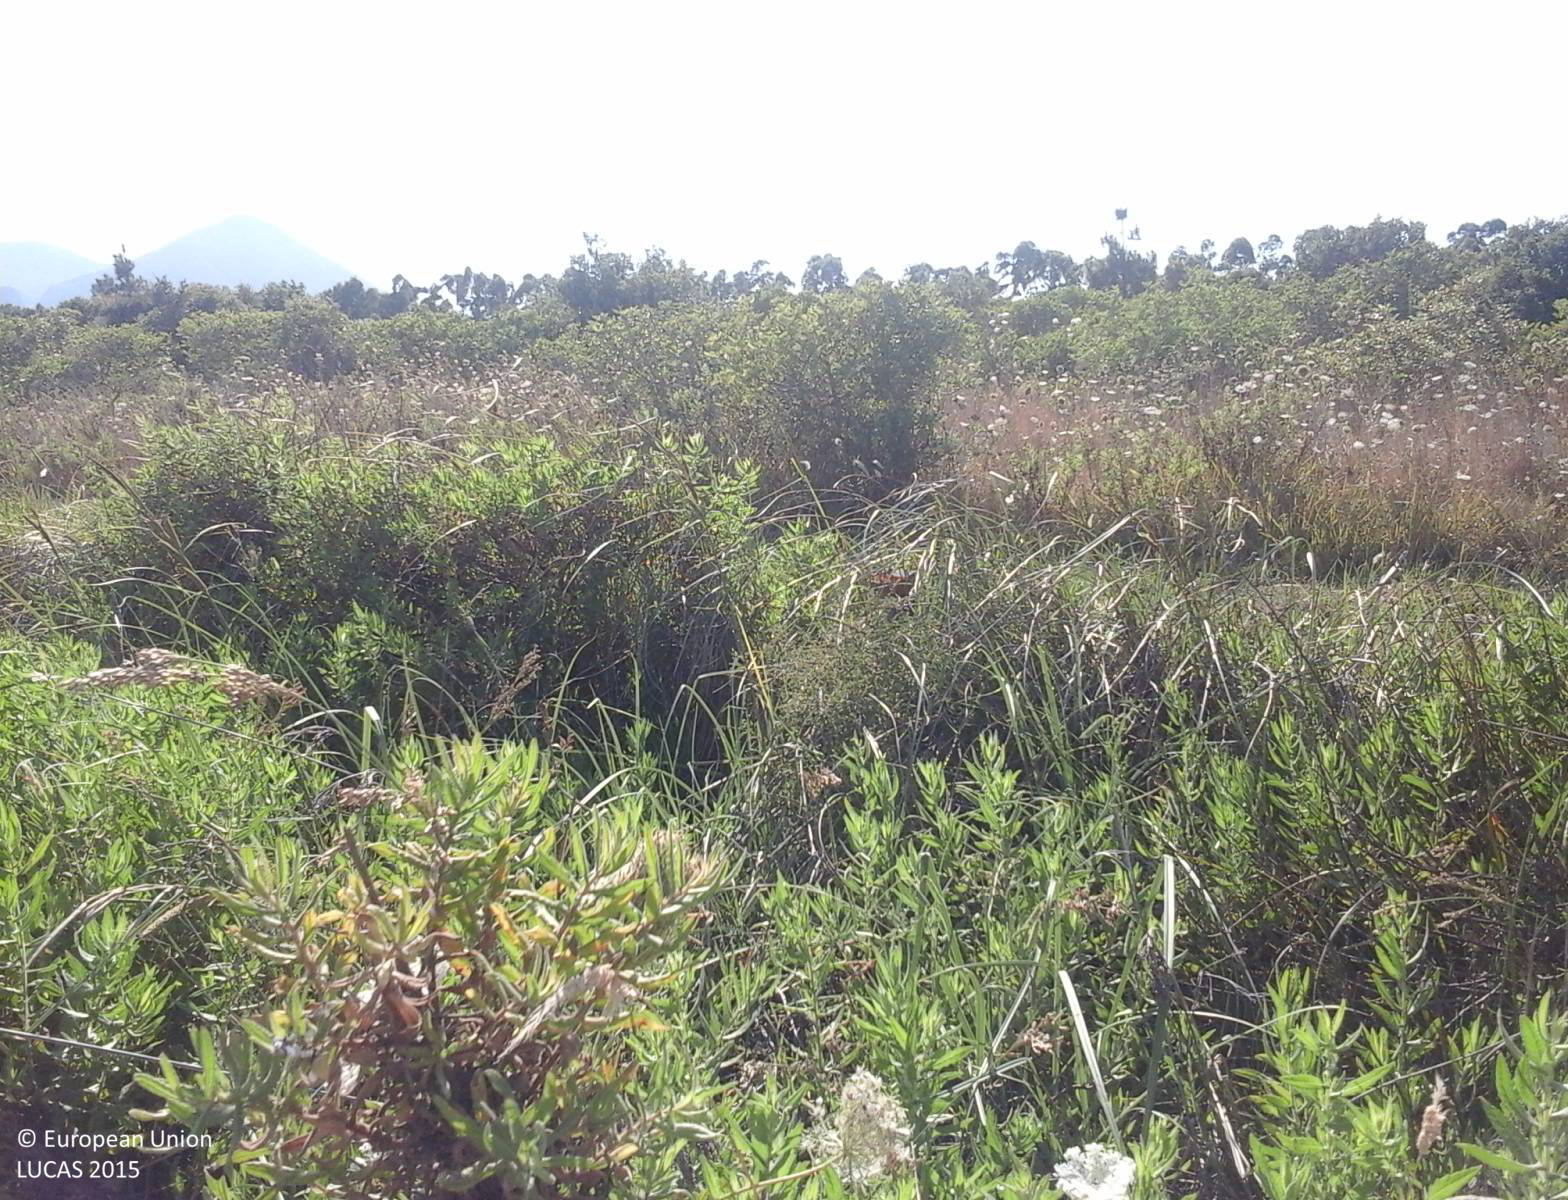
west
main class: Grassland
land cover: Grassland without tree/shrub cover
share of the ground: > 75 %
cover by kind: herbaceous plants 100 %
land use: Semi-natural and natural areas not in use
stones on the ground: 25 - 50 %
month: June
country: IT
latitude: 39.4810
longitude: 8.7865
